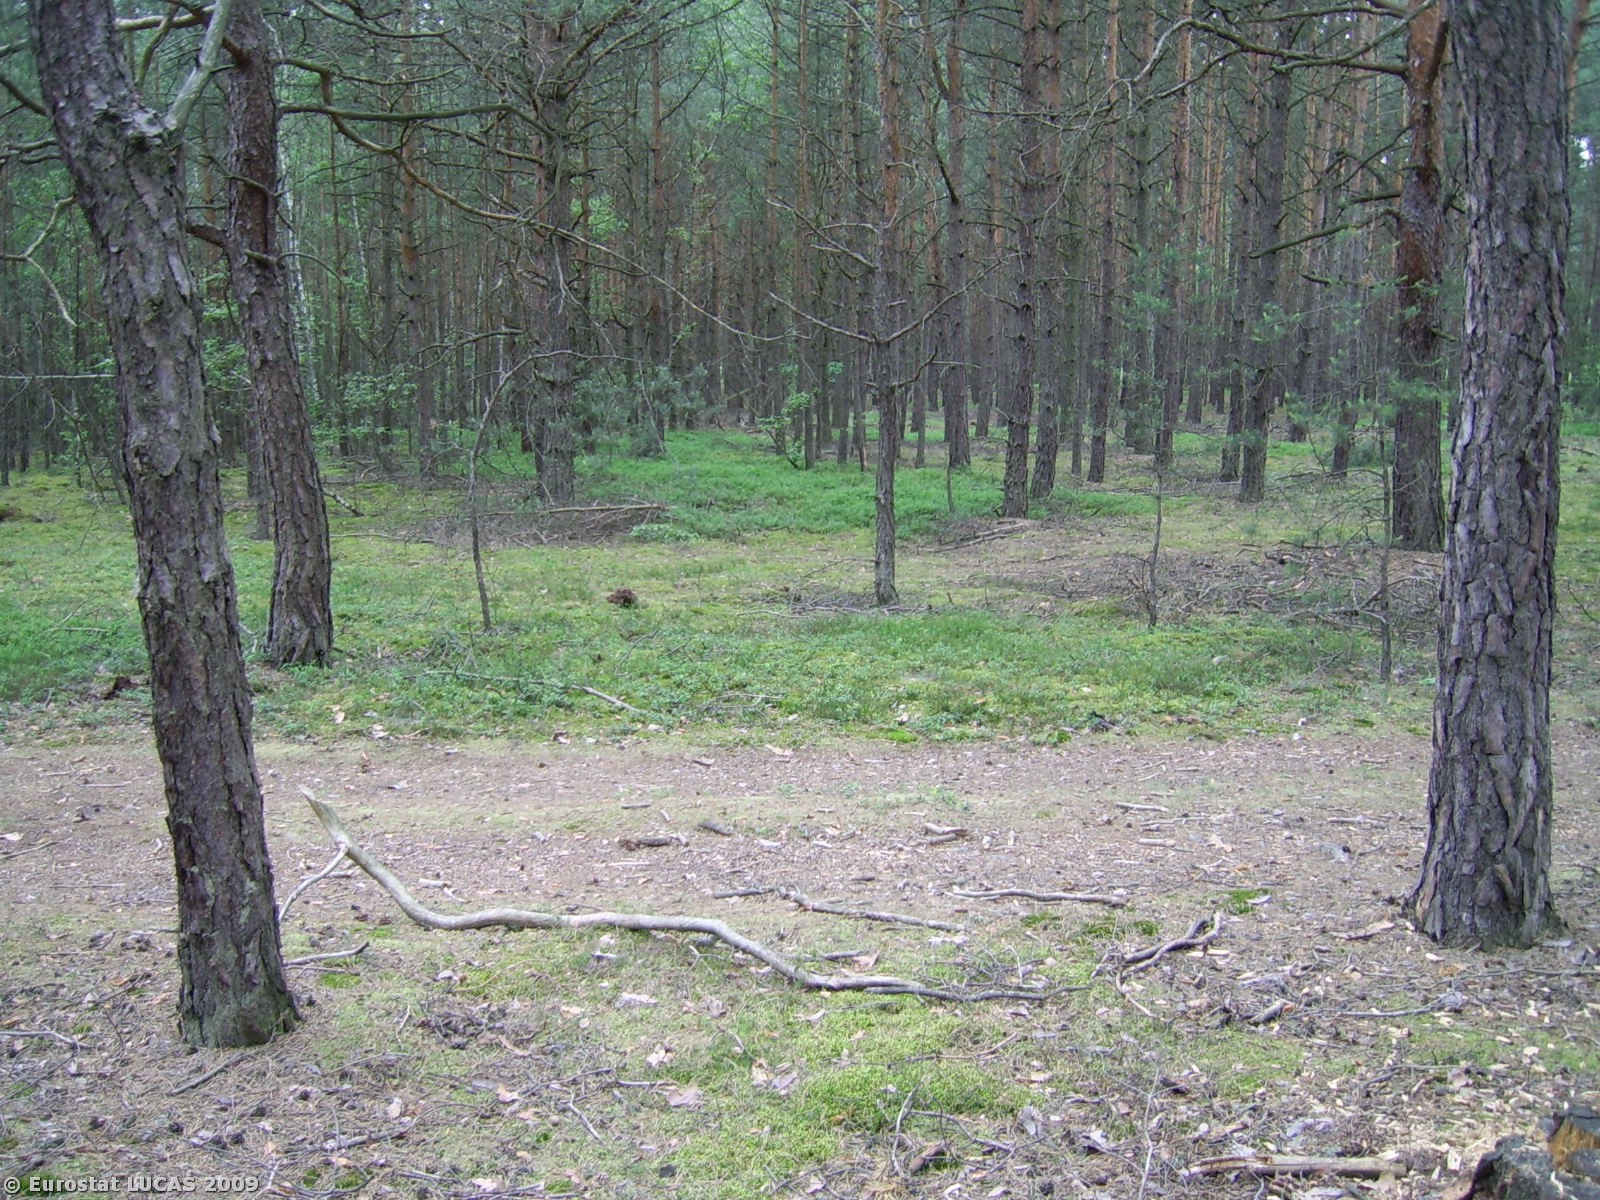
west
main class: Woodland
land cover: Coniferous woodland
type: hemiboreal forest and nemoral coniferous forest and mixed broadleaved-coniferous forest
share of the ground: 50 - 75 %
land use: Forestry
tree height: > 5 m
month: June
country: PL
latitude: 52.0493
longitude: 17.7865
